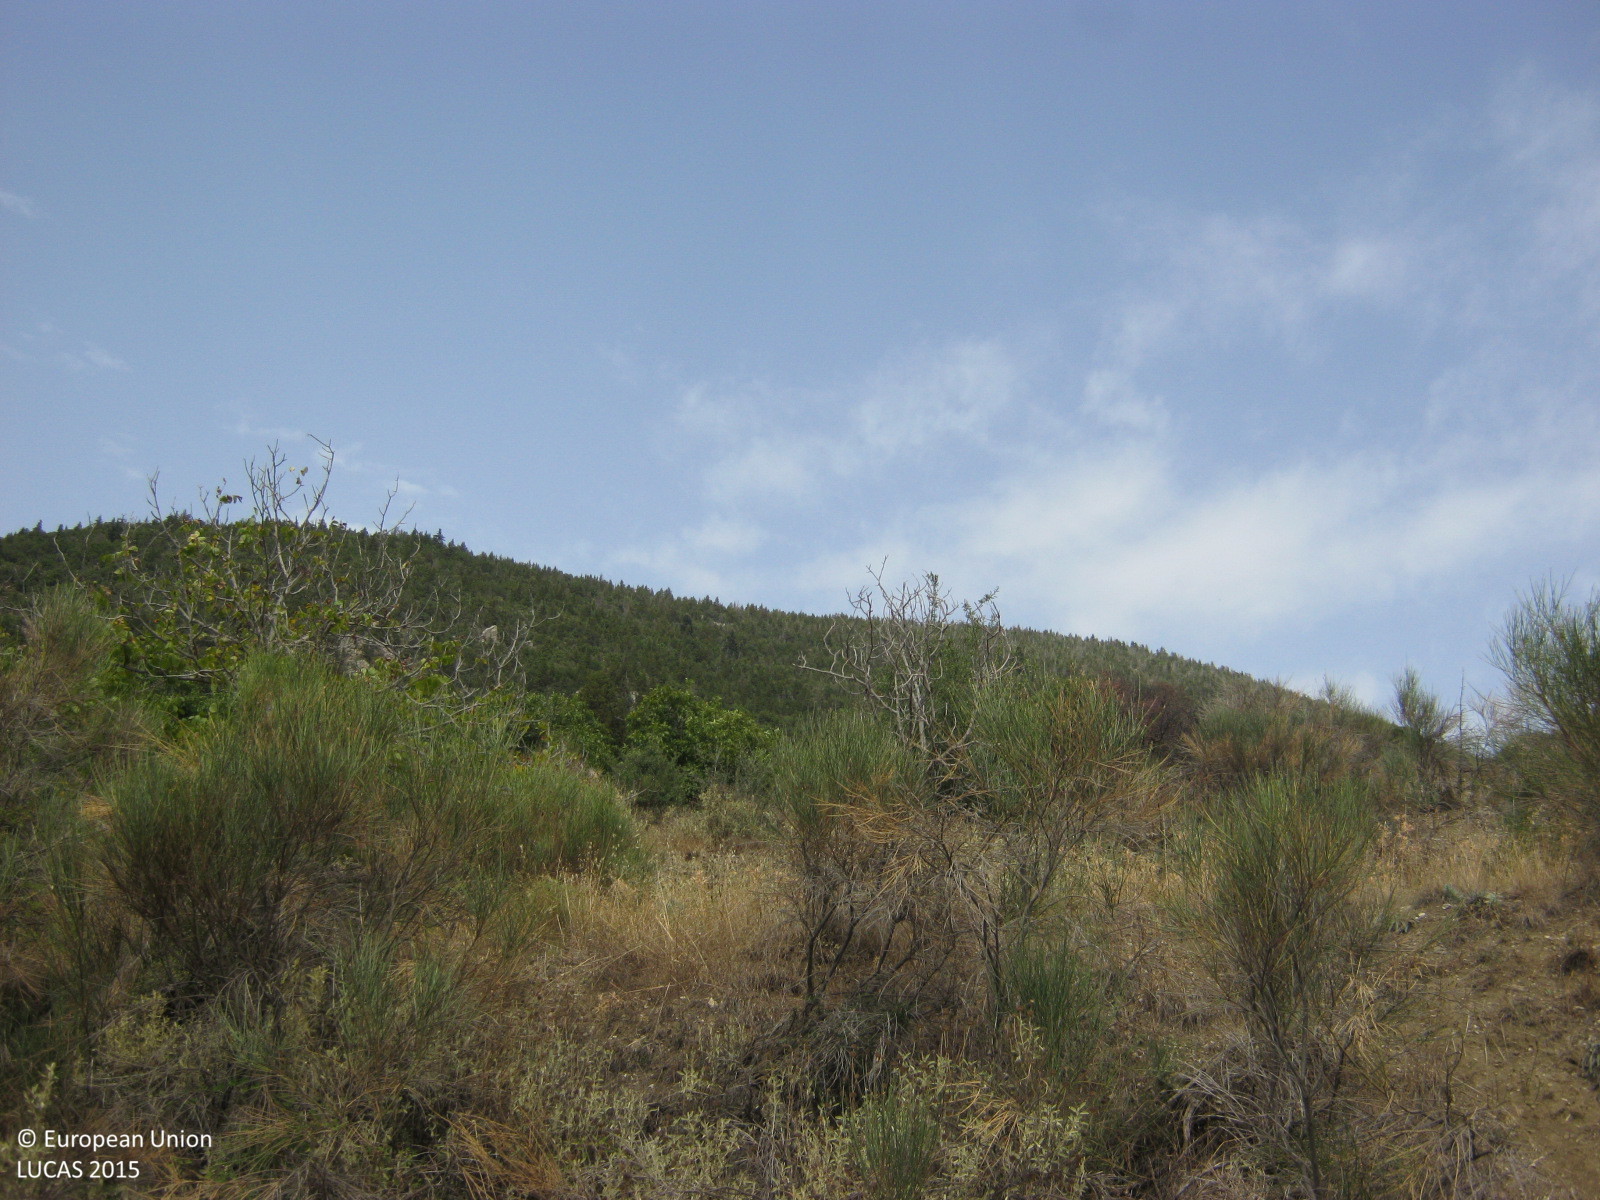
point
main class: Woodland
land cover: Spruce dominated coniferous woodland
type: coniferous forest of the mediterranean region
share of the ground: > 75 %
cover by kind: coniferous forest trees 90 %, unconsolidated bare surface 10 %
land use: Forestry
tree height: > 5 m
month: September
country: GR
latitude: 37.1888
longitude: 22.6774
